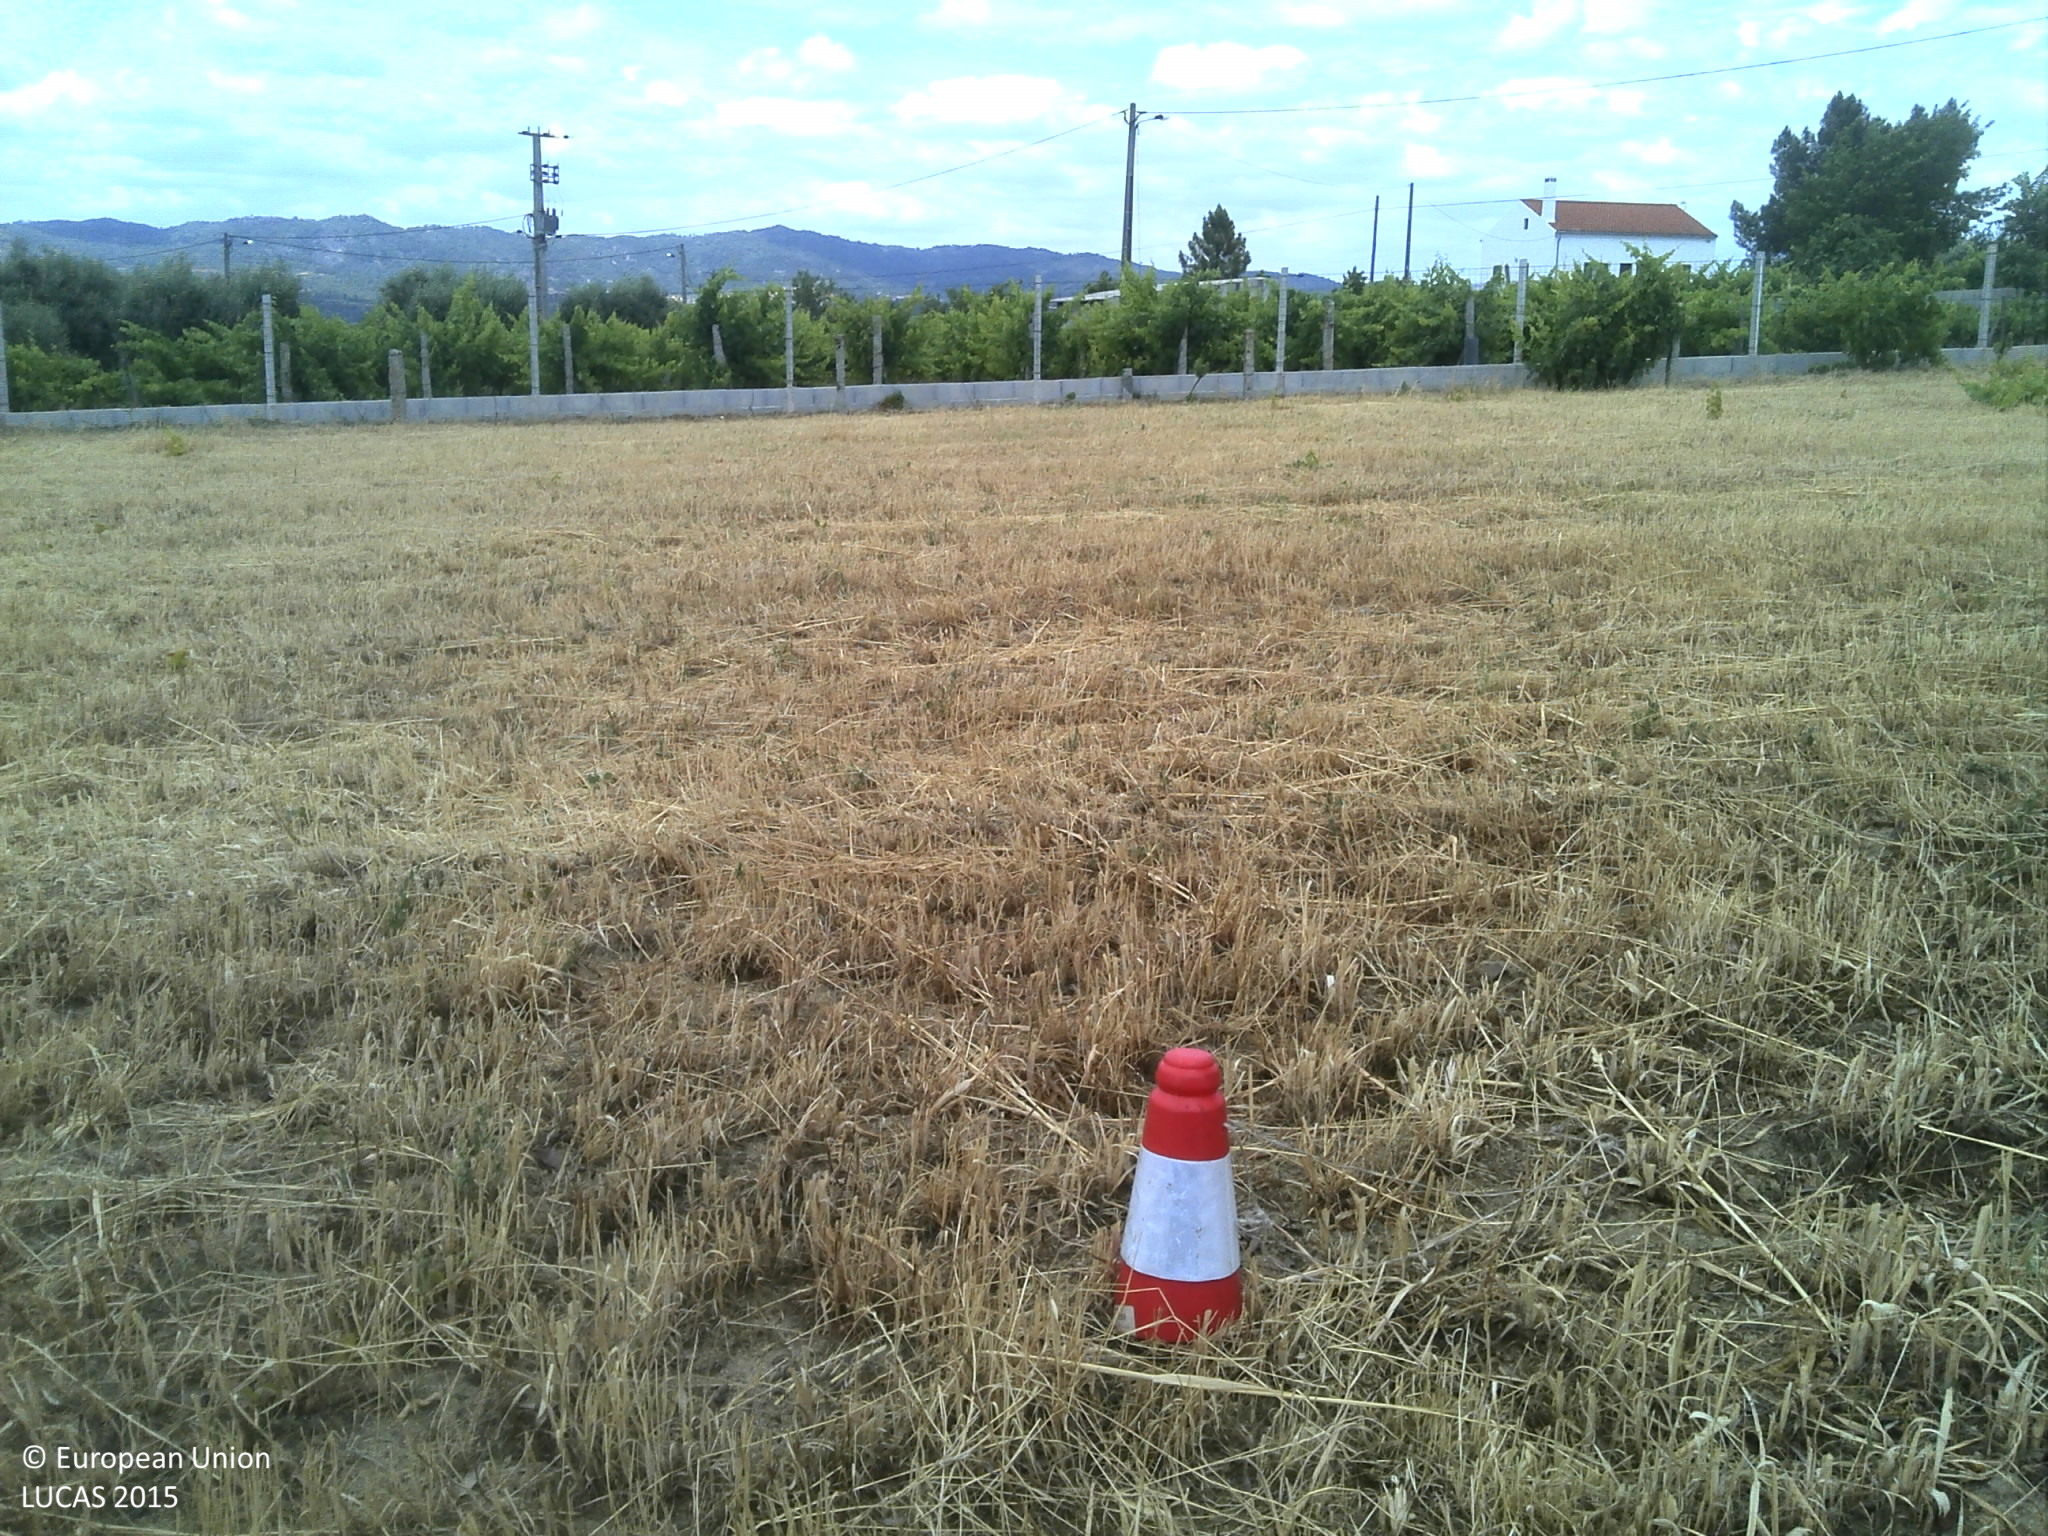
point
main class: Cropland
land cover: Oats
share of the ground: < 10 %
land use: Agriculture (excluding fallow land and kitchen gardens)
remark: Harvested field
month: June
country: PT
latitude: 40.1627
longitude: -7.4697
